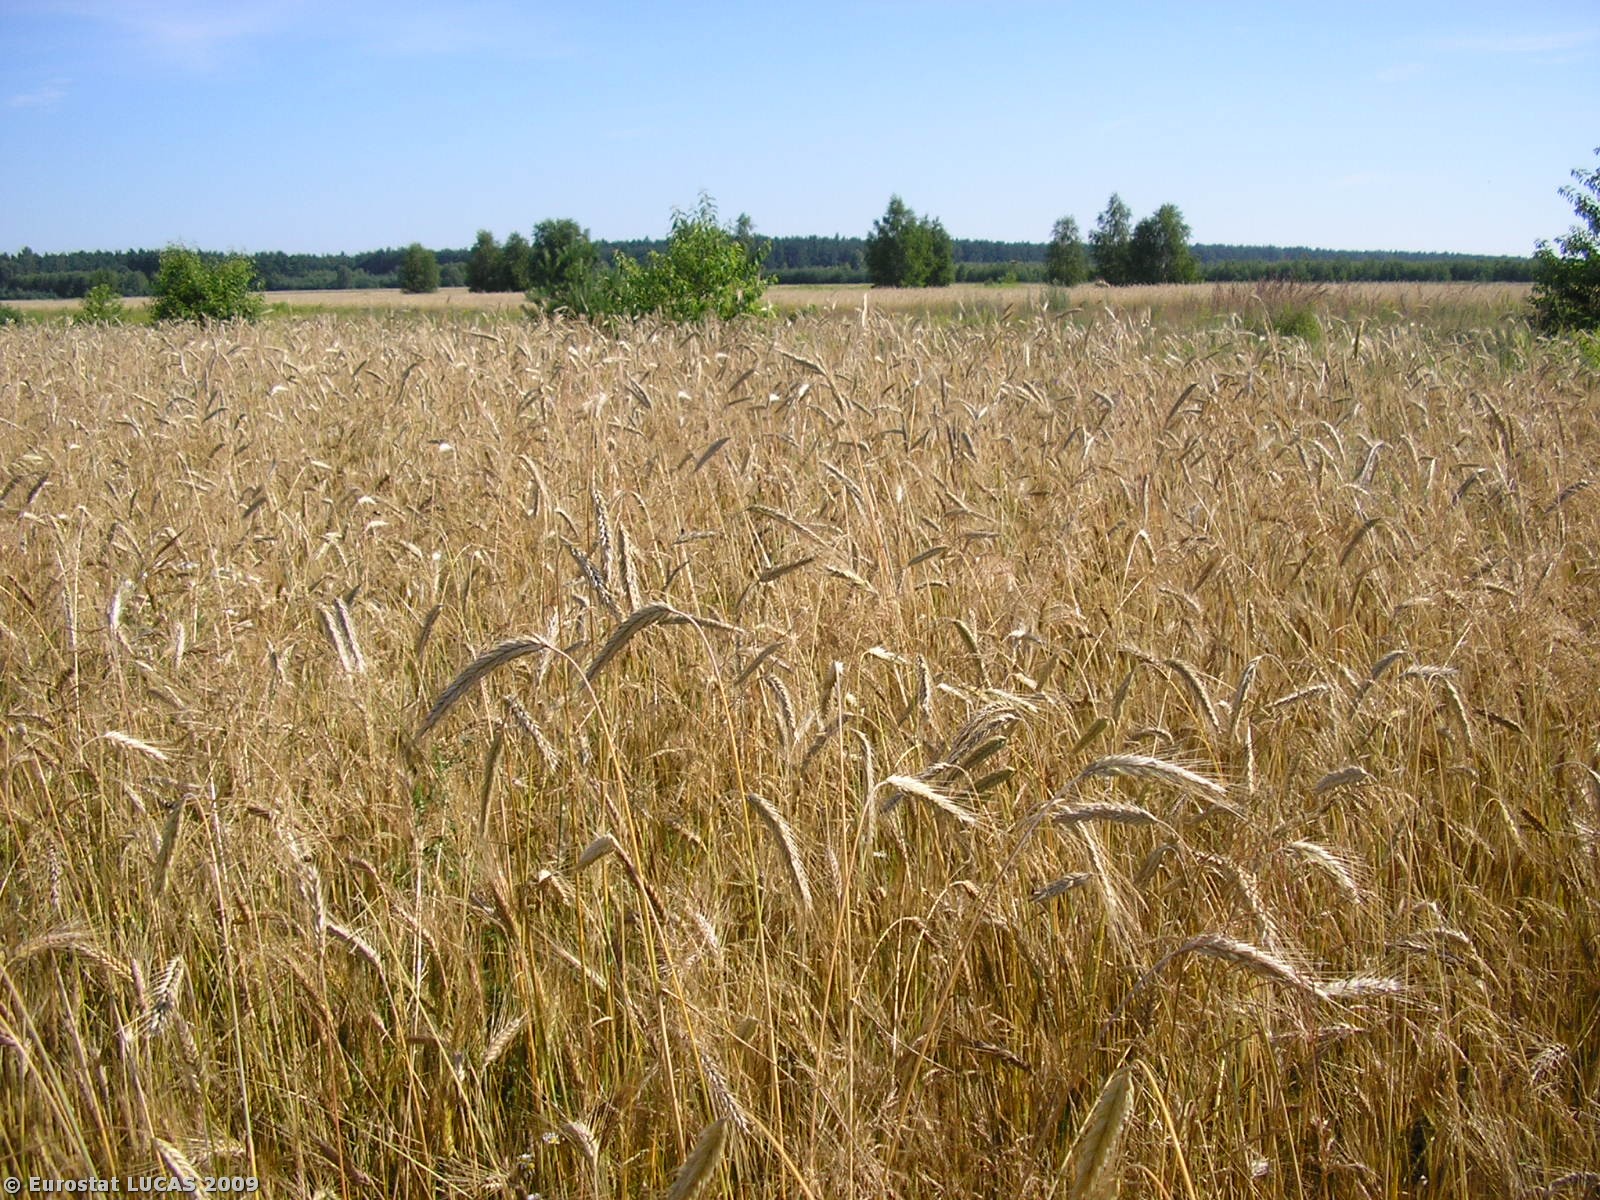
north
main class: Cropland
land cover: Triticale
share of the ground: > 75 %
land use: Agriculture (excluding fallow land and kitchen gardens)
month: July
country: PL
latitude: 52.4841
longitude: 20.7763
